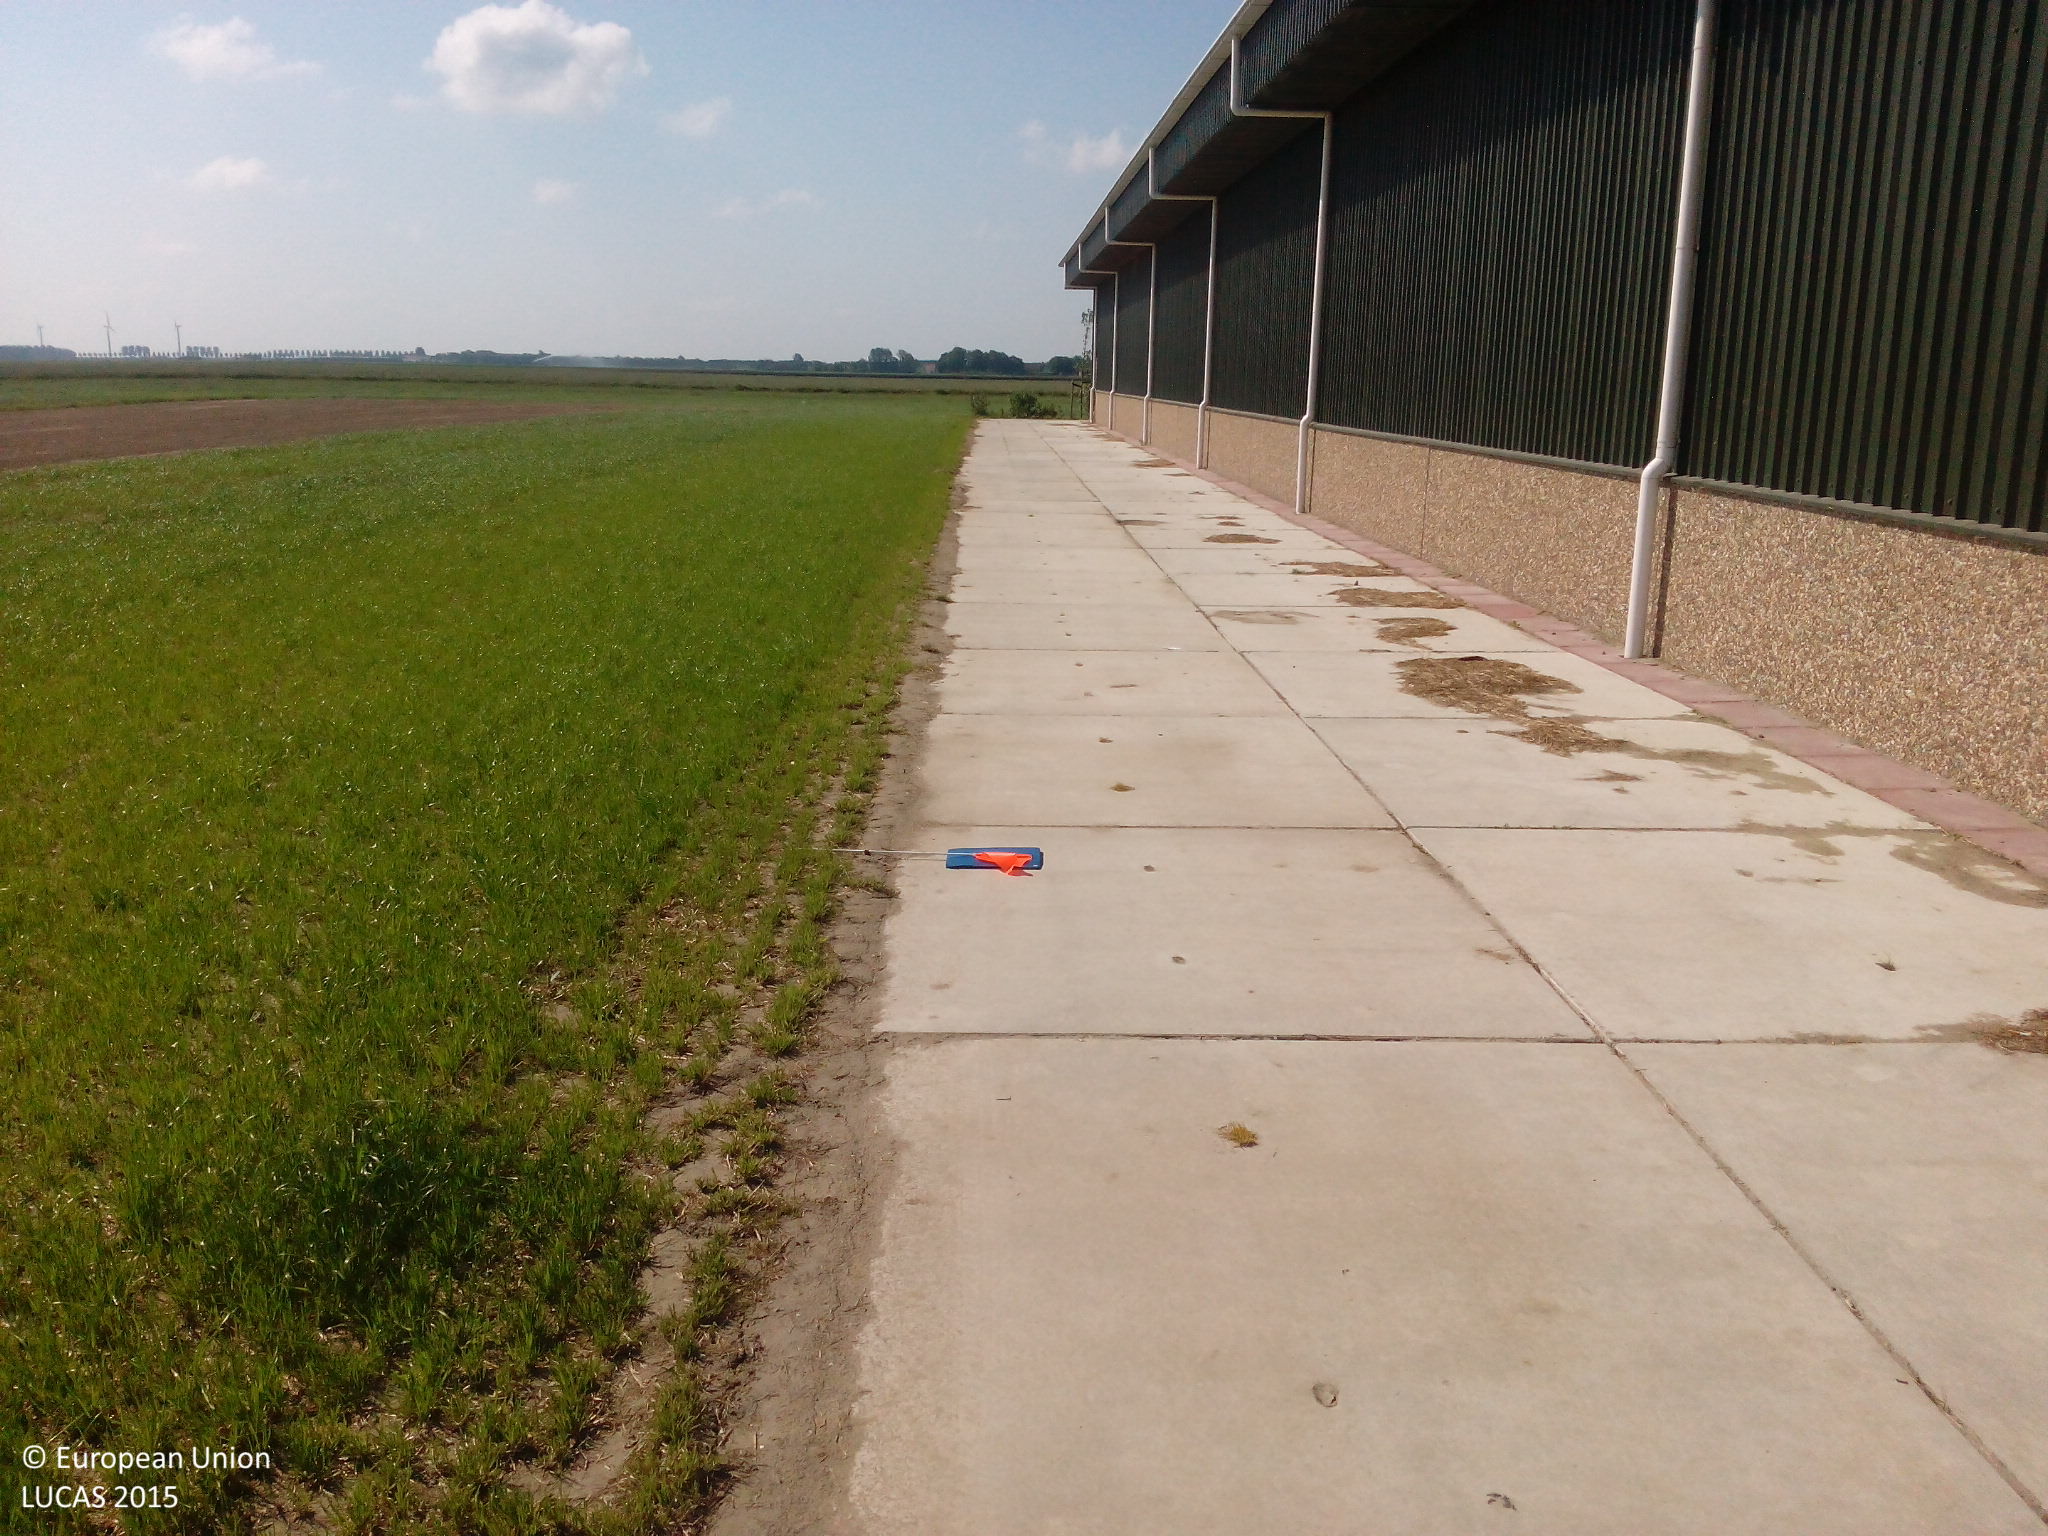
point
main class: Grassland
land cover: Grassland without tree/shrub cover
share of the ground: > 75 %
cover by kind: herbaceous plants 80 %, unconsolidated bare surface 20 %
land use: Agriculture (excluding fallow land and kitchen gardens)
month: June
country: NL
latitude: 51.7427
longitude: 4.0710
